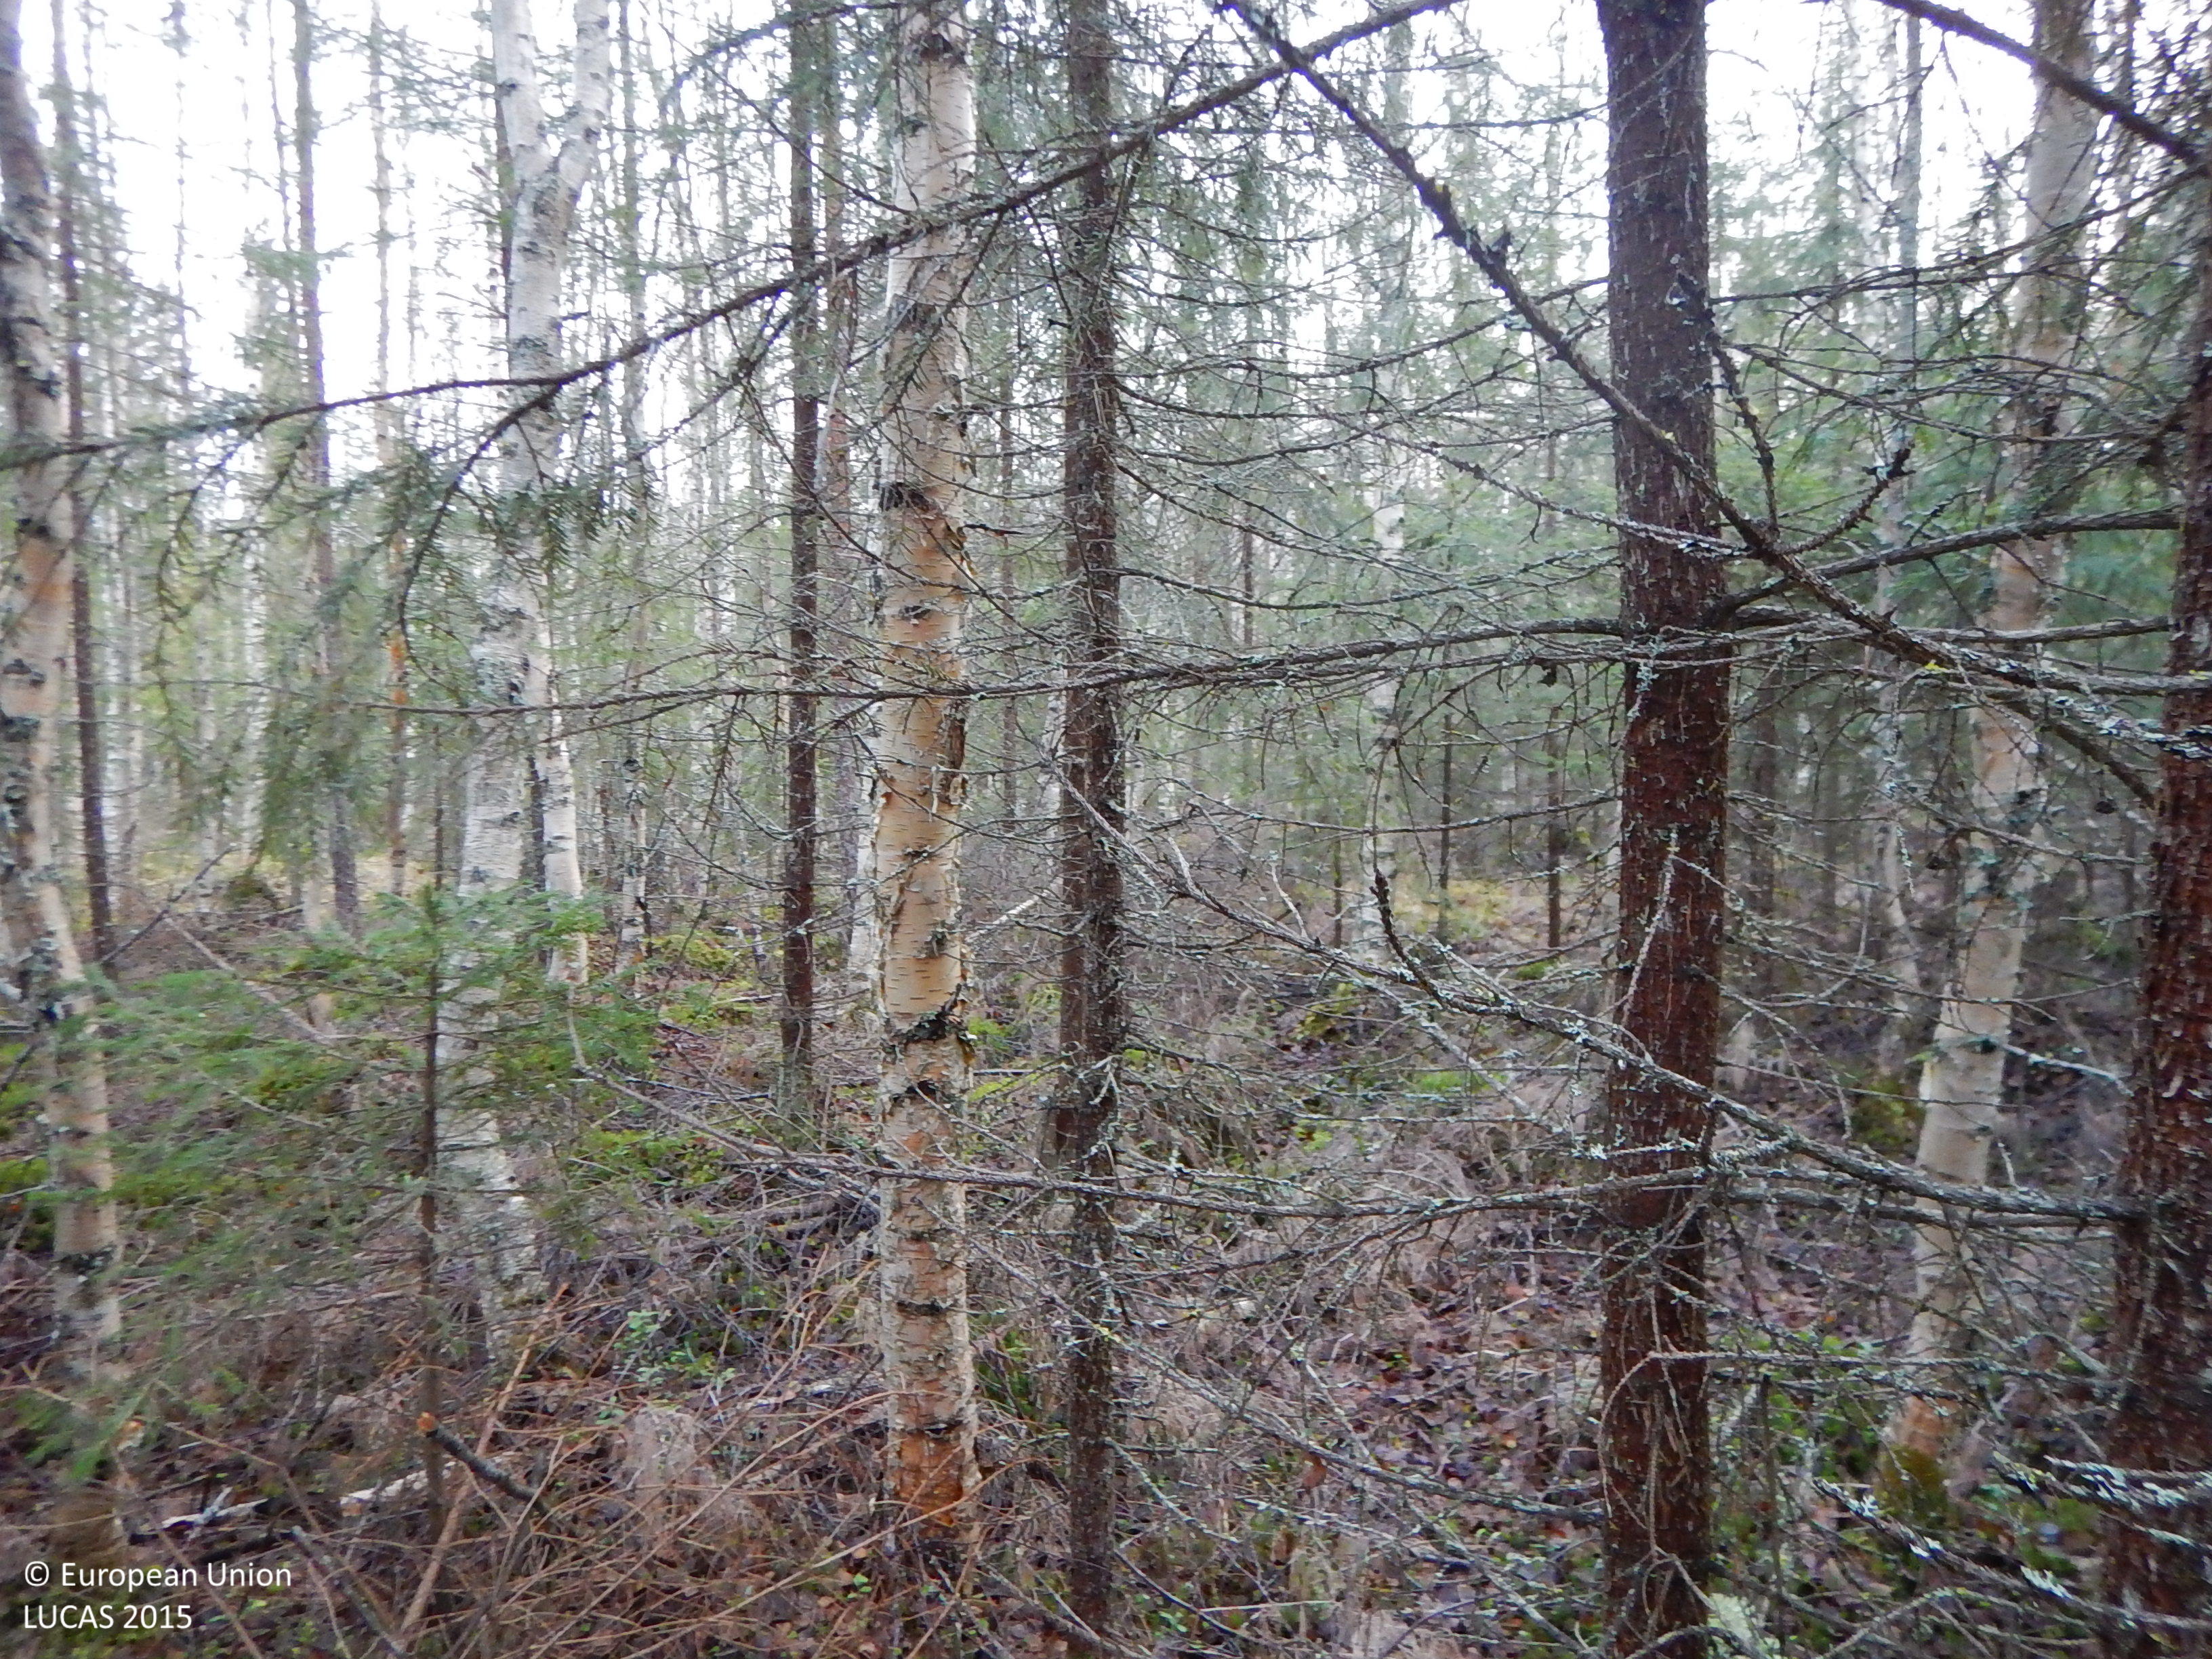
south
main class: Woodland
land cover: Spruce dominated mixed woodland
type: boreal forest
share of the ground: 50 - 75 %
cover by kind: coniferous forest trees 30 %, broadleaved forest trees 30 %, herbaceous plants 20 %, shrubs 10 %, lichens and mosses 10 %
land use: Forestry
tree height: > 5 m
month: October
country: SE
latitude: 65.4063
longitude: 21.2355
